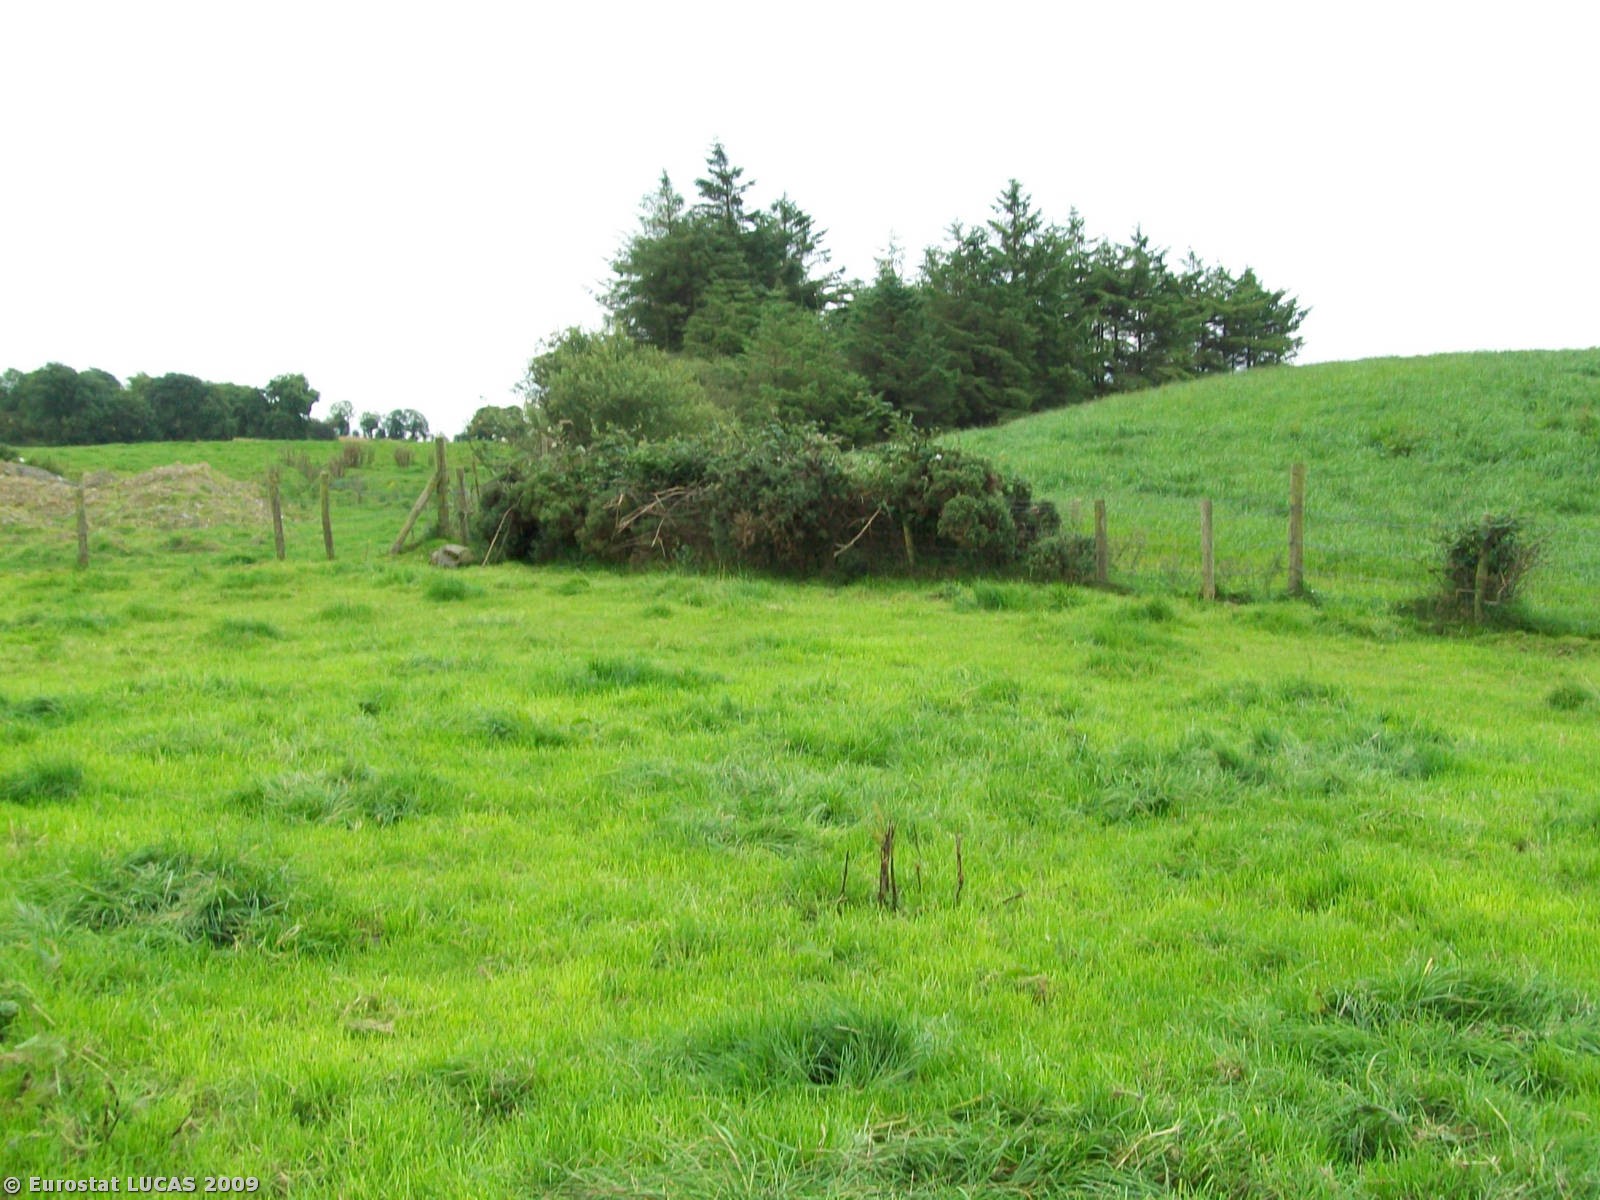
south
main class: Grassland
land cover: Grassland without tree/shrub cover
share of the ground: > 75 %
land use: Agriculture (excluding fallow land and kitchen gardens)
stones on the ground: 10 - 25 %
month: August
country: GB
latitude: 54.1712
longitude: -6.6271
